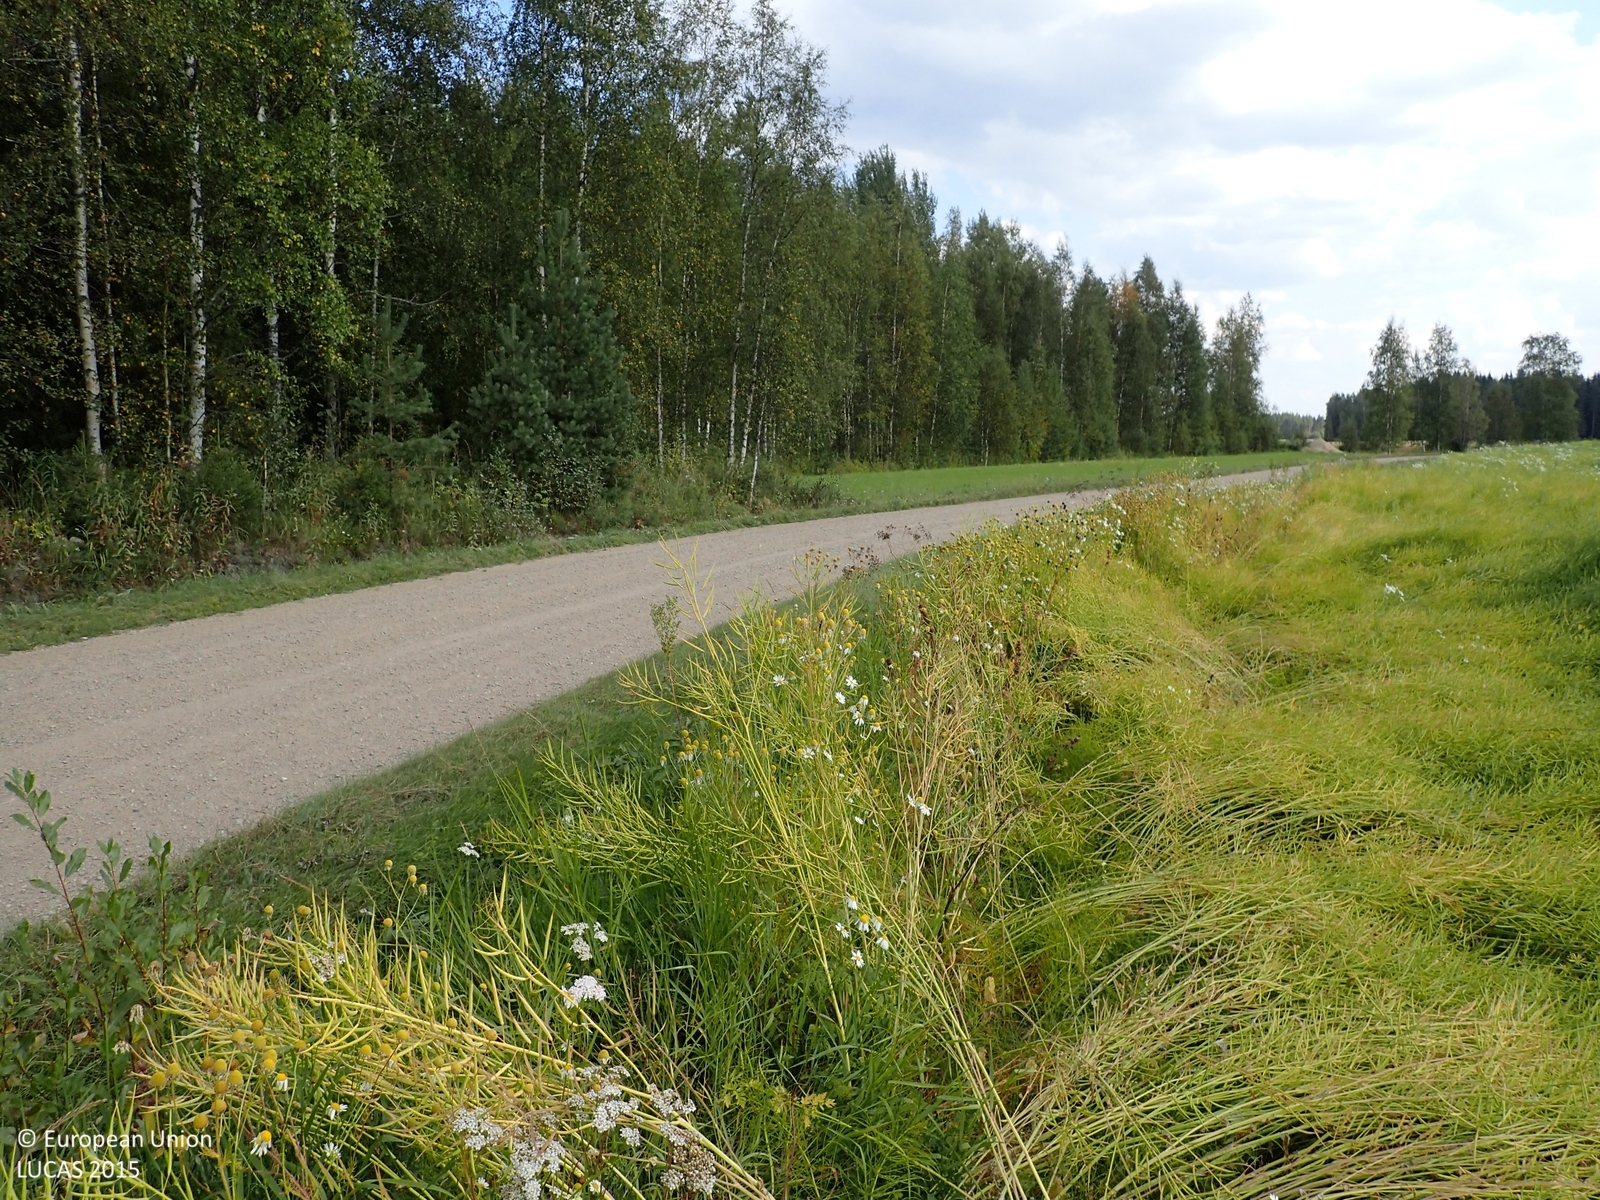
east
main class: Cropland
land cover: Rape and turnip rape
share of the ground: > 75 %
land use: Agriculture (excluding fallow land and kitchen gardens)
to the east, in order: Rape and turnip rape; Shruby margins; Ditches and canals; Grass margins; Paved roads, cycling and walking lanes; Grass margins; Ditches and canals; Temporary grasslands; Ditches and canals; Lines of trees; Tracks; Broadleaved woodland; Other mixed woodland; Tracks; Abandoned hedges; Ditches and canals; Common wheat; Shruby margins; Ditches and canals; Other mixed woodland
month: August
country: FI
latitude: 62.7010
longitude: 22.6227
